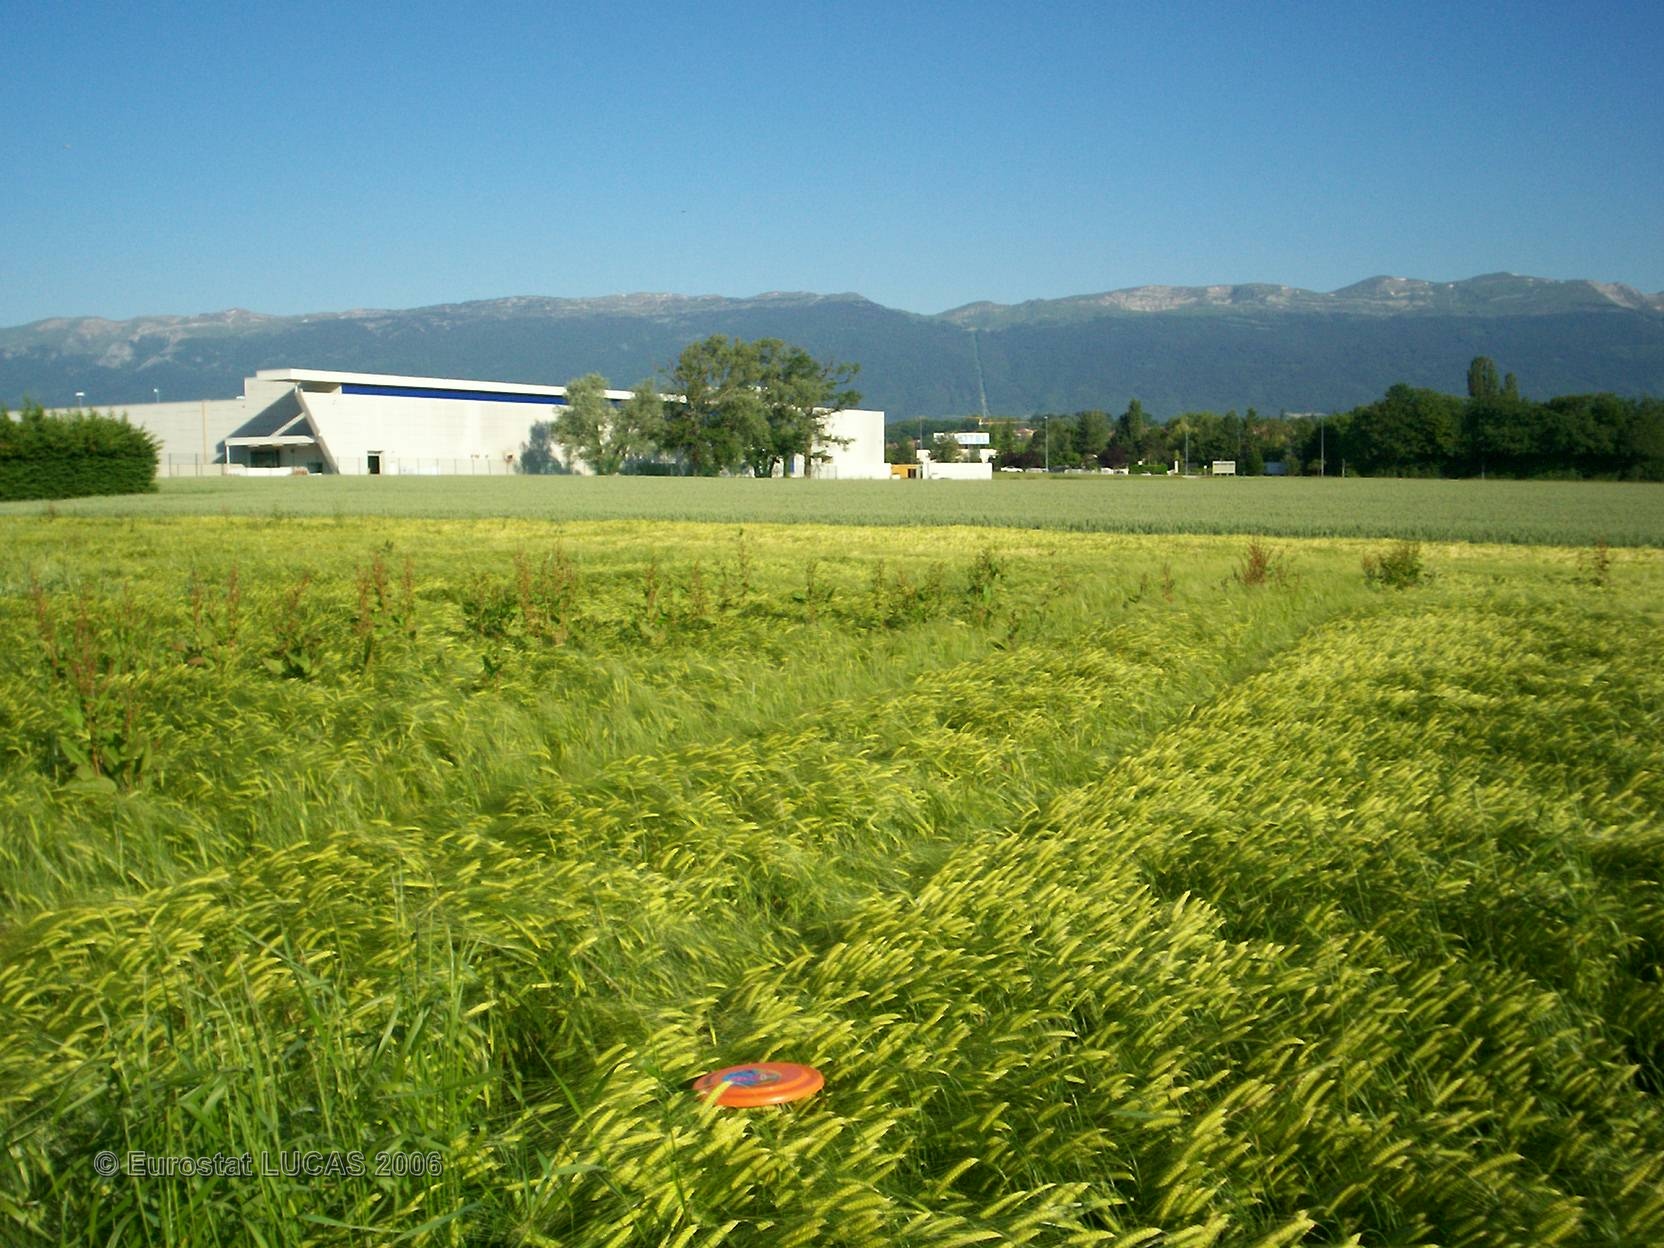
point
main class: Cropland
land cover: Barley
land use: Agriculture (excluding fallow land and kitchen gardens)
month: June
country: FR
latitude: 46.2441
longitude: 6.0995
